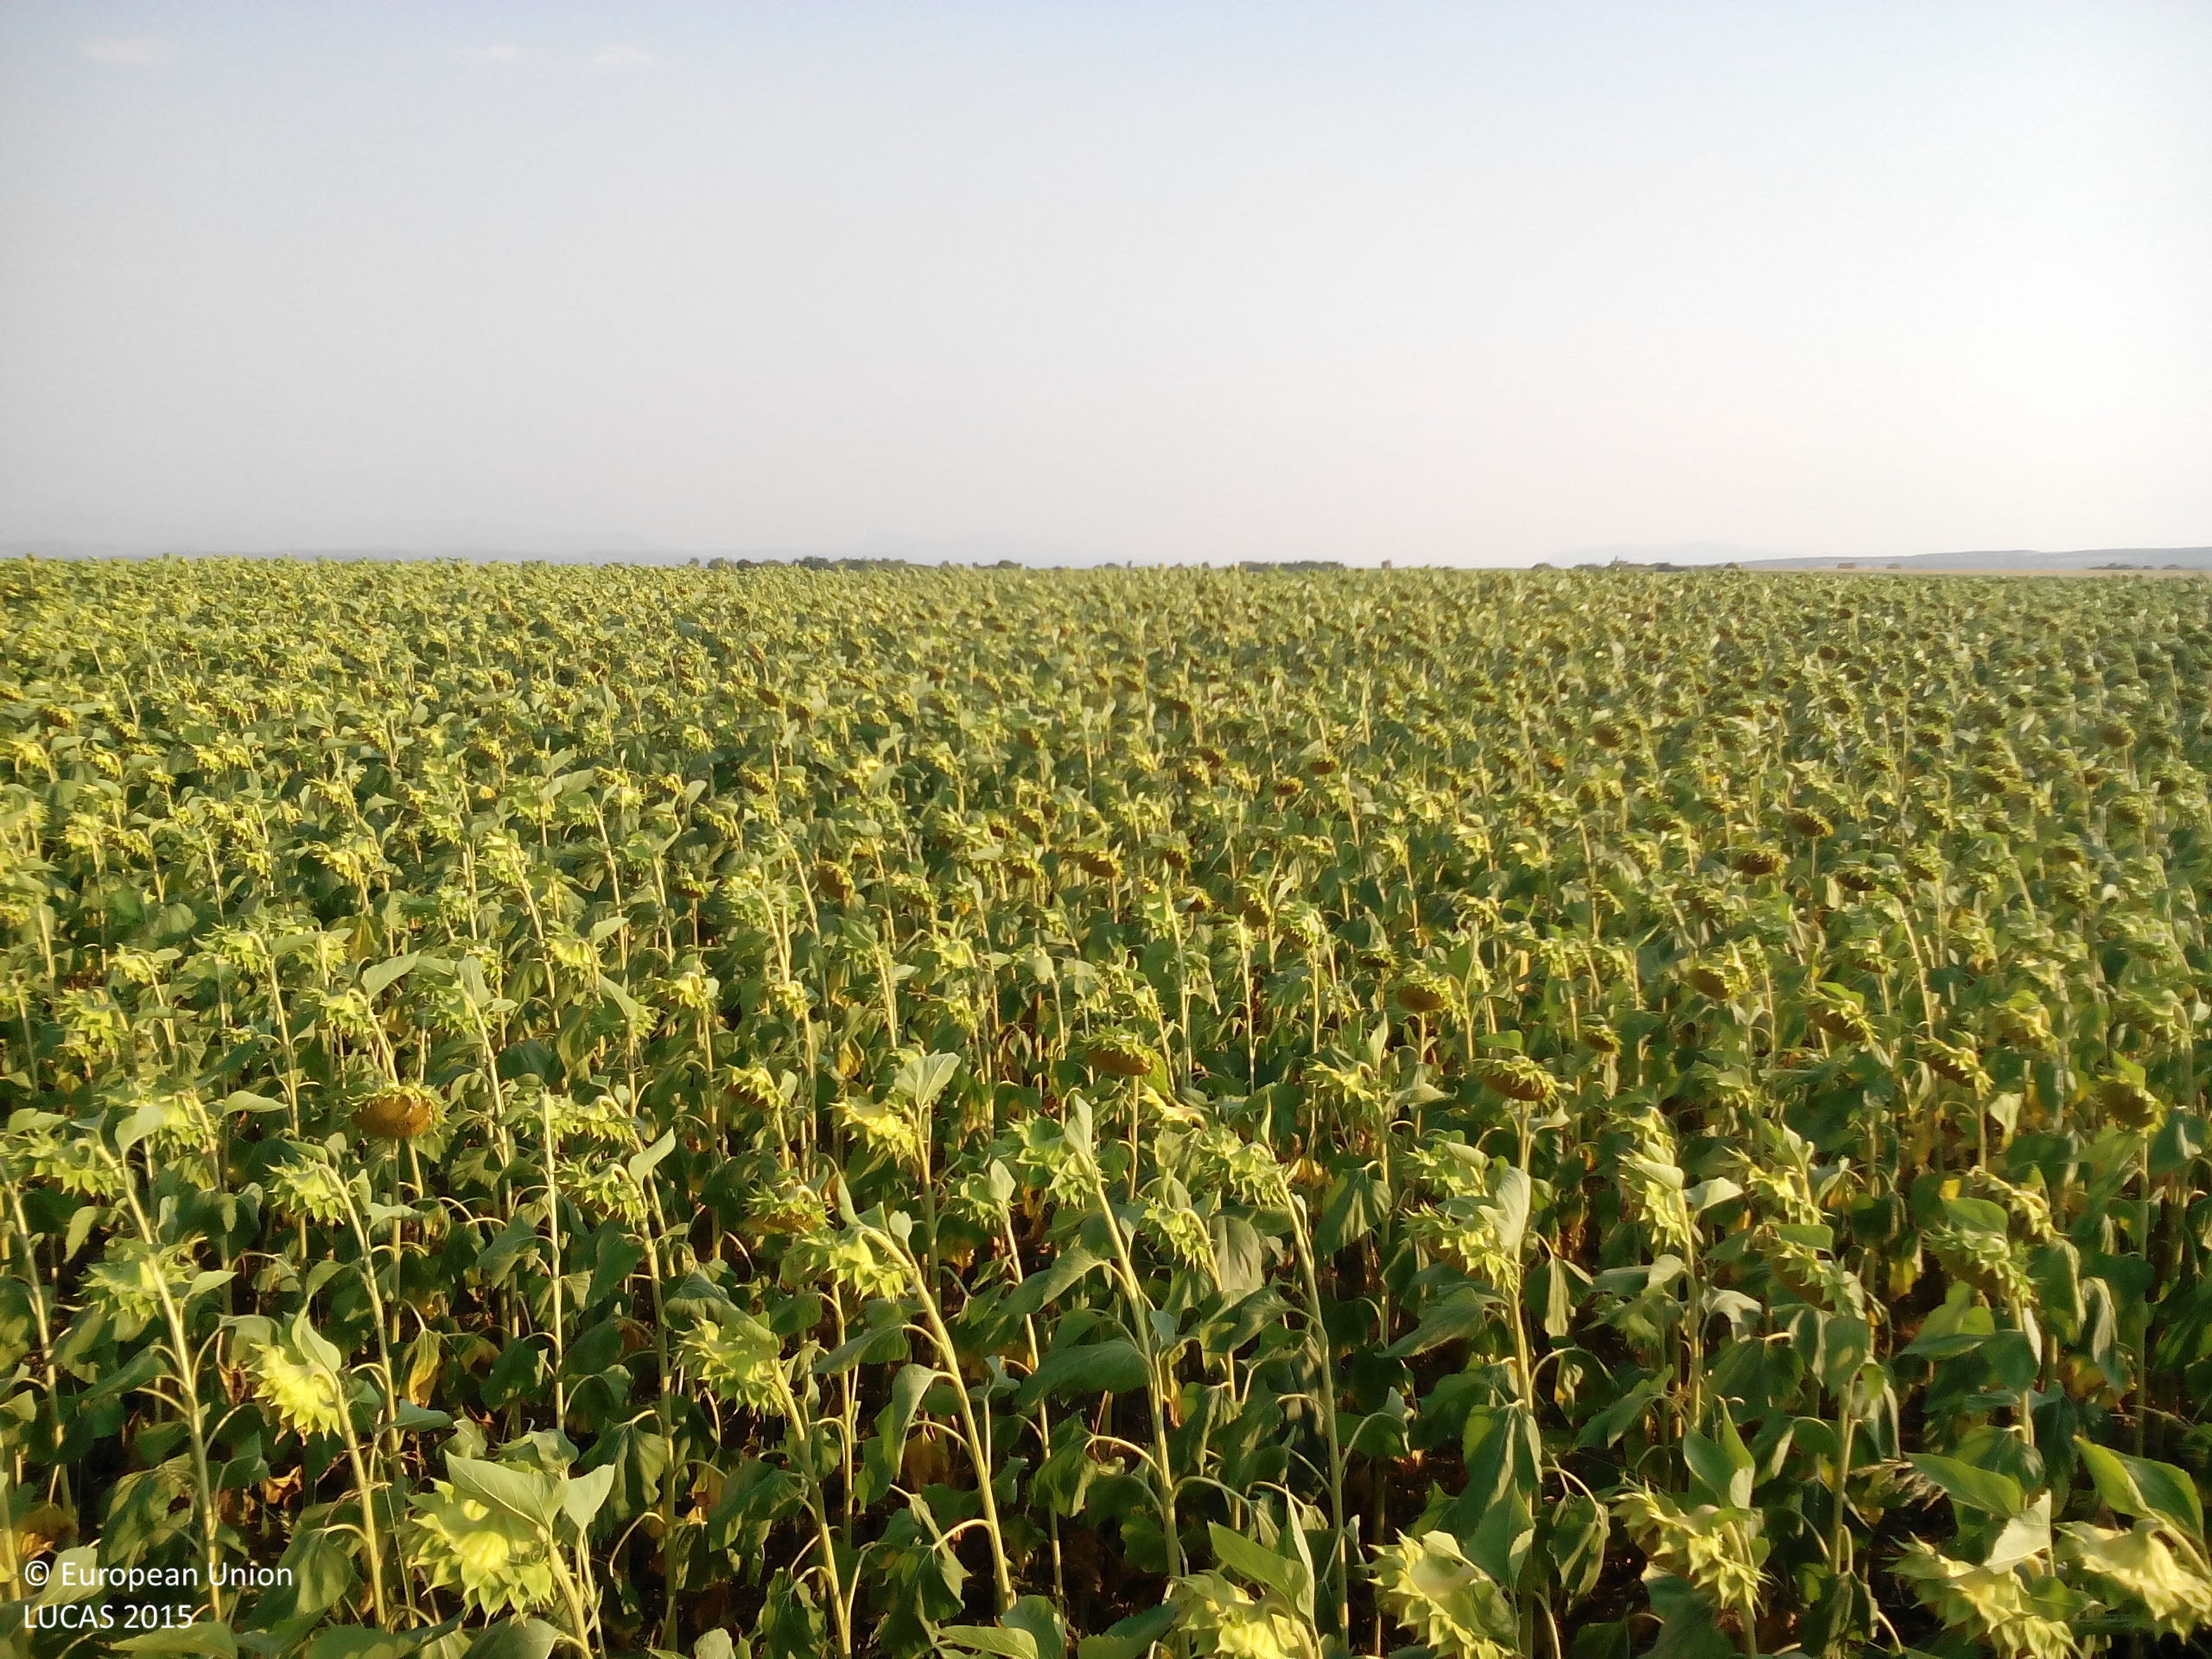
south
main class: Cropland
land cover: Sunflower
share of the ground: > 75 %
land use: Agriculture (excluding fallow land and kitchen gardens)
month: July
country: BG
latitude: 43.2288
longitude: 24.1505
